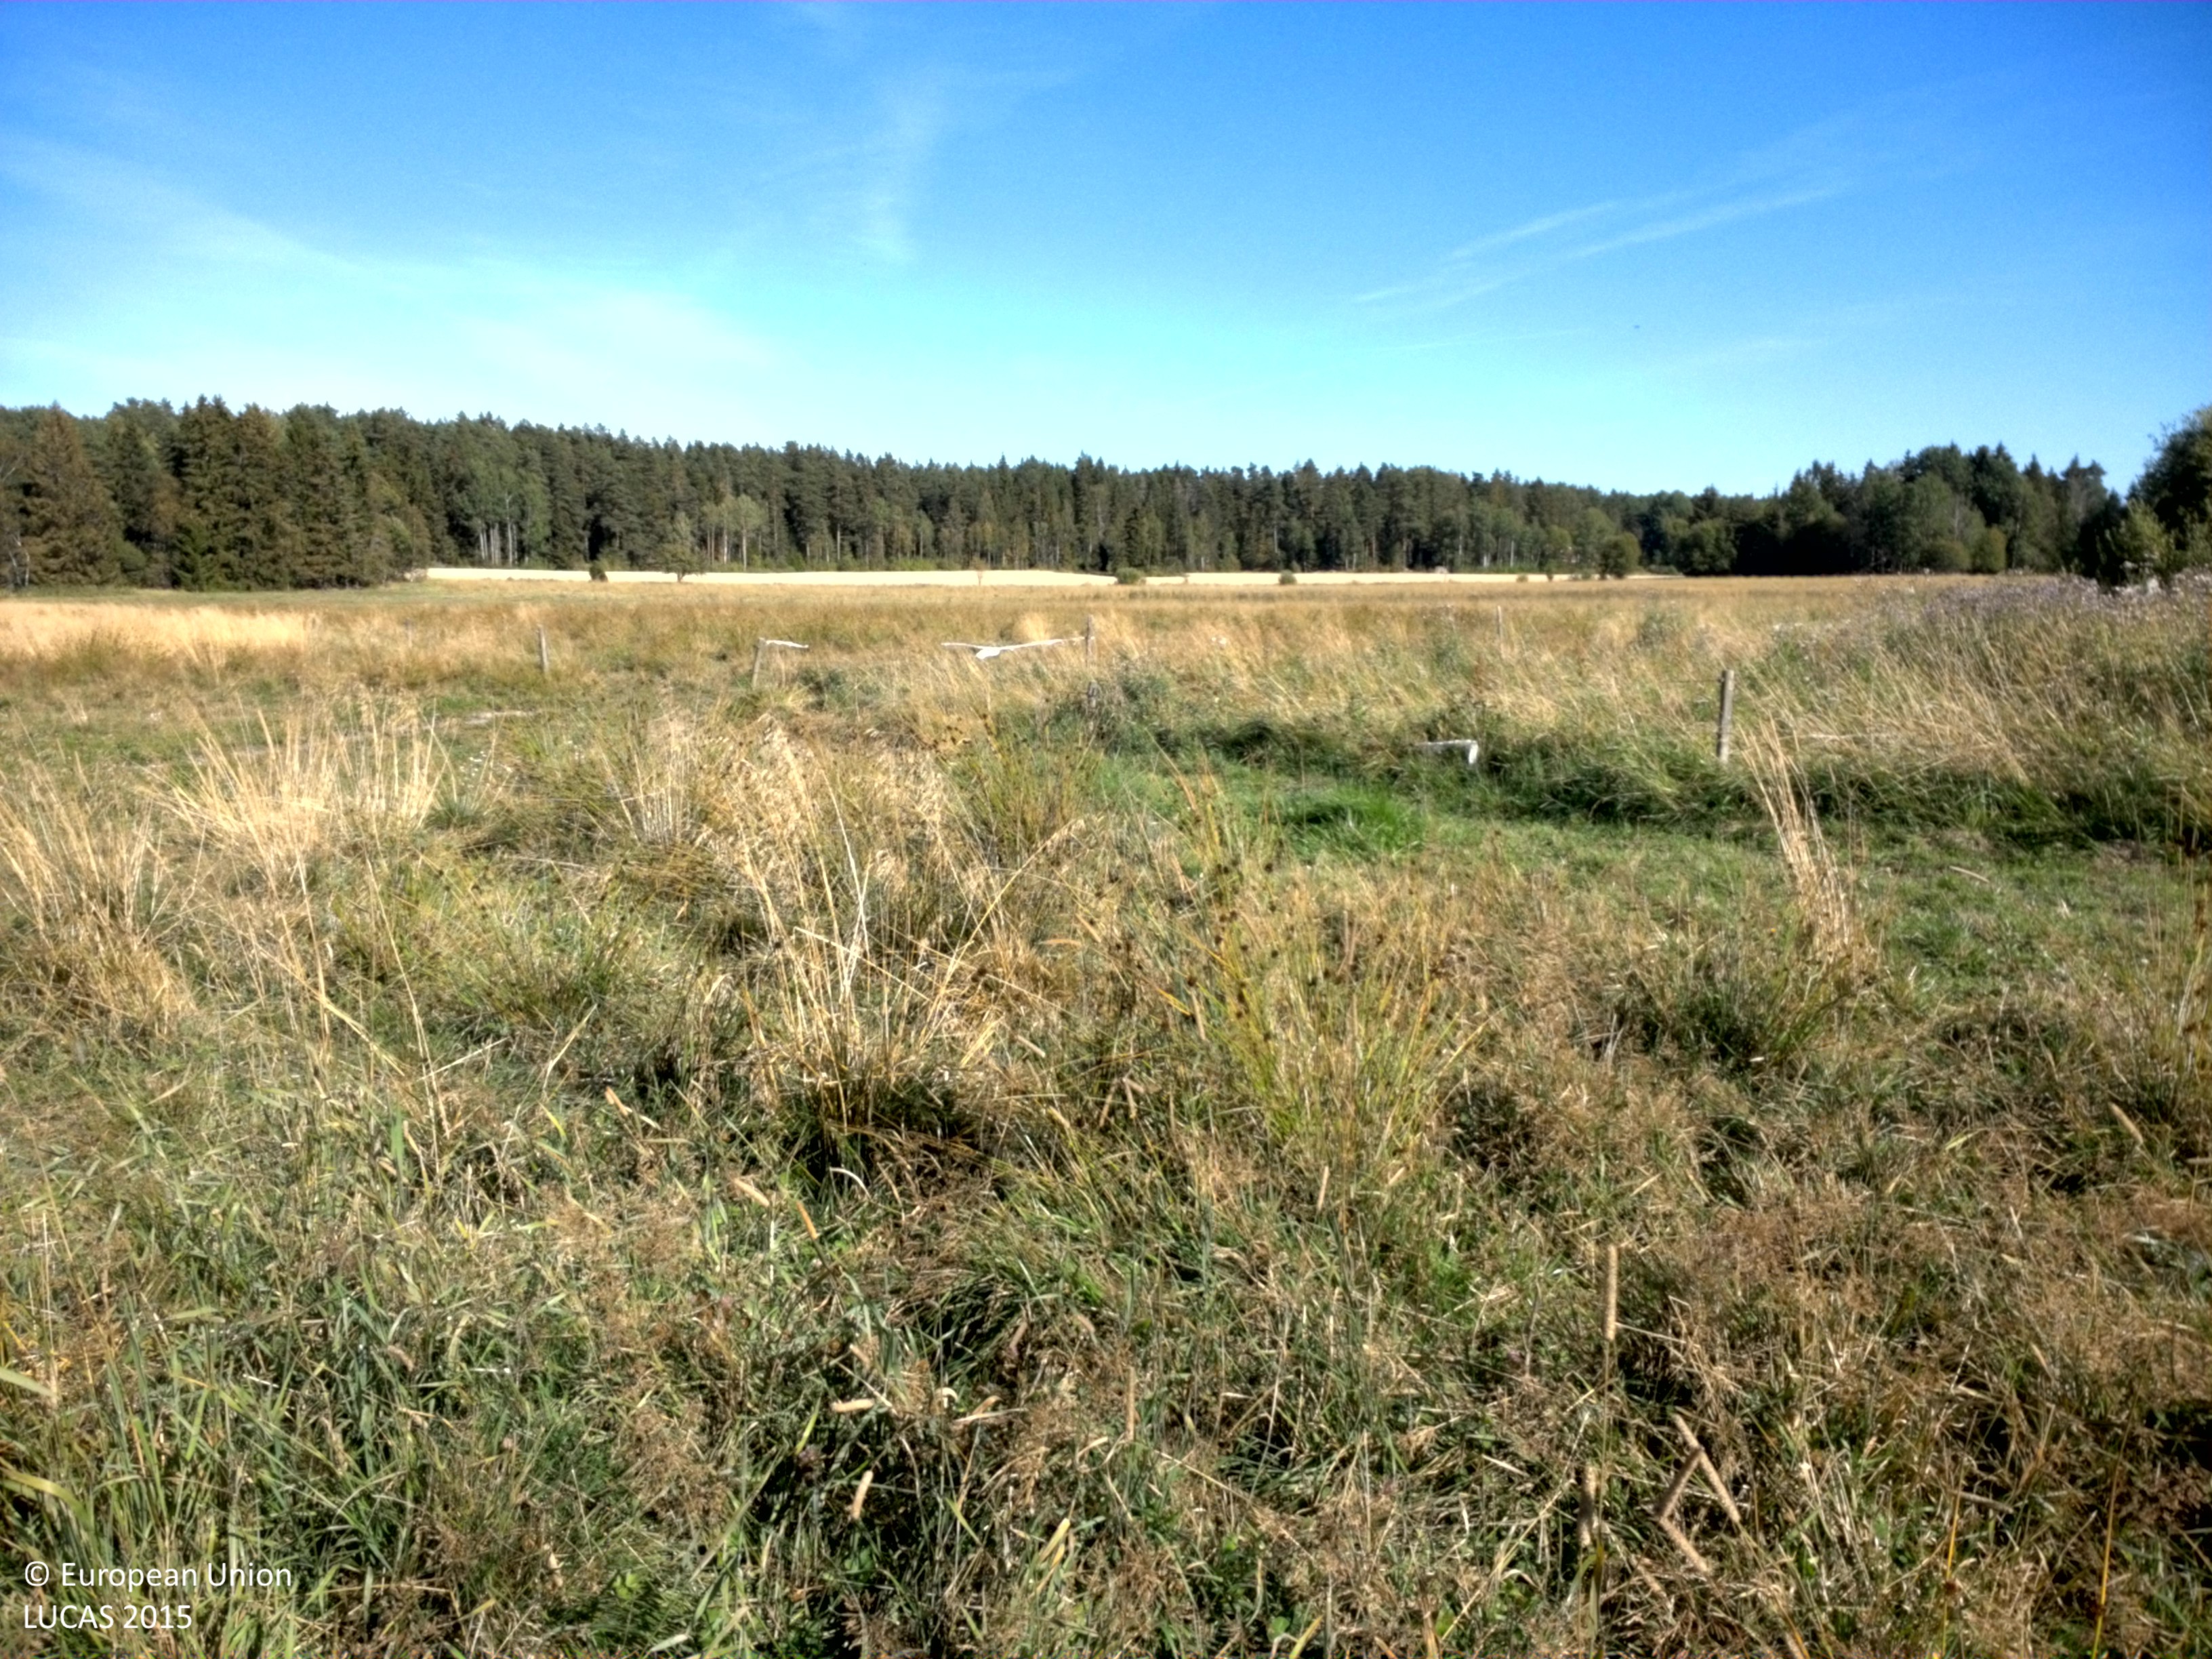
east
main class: Grassland
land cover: Grassland without tree/shrub cover
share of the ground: > 75 %
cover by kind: herbaceous plants 100 %
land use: Agriculture (excluding fallow land and kitchen gardens)
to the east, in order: Grassland without tree/shrub cover; Fences; Grassland without tree/shrub cover
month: August
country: SE
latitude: 59.7937
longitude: 16.9241
